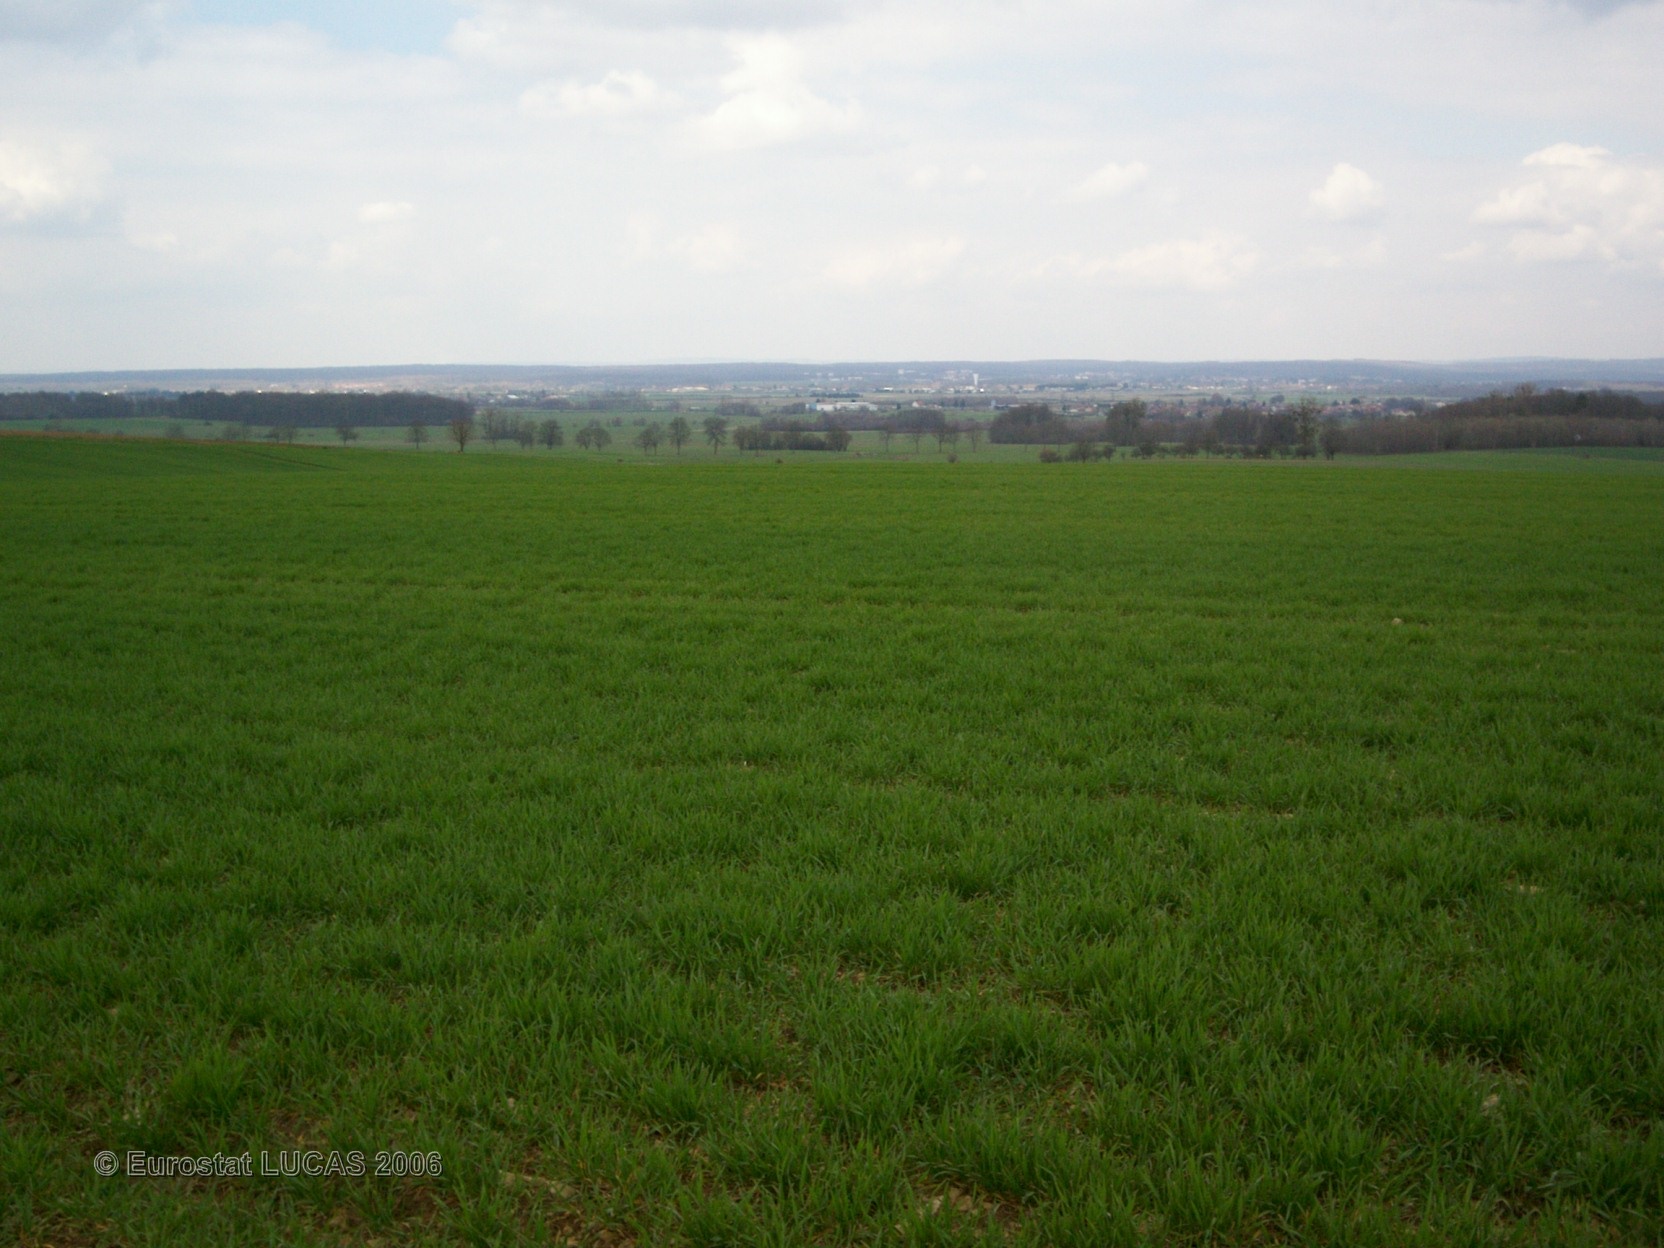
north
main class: Cropland
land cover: Common wheat
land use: Agriculture (excluding fallow land and kitchen gardens)
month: April
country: FR
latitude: 47.7491
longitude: 6.3599
